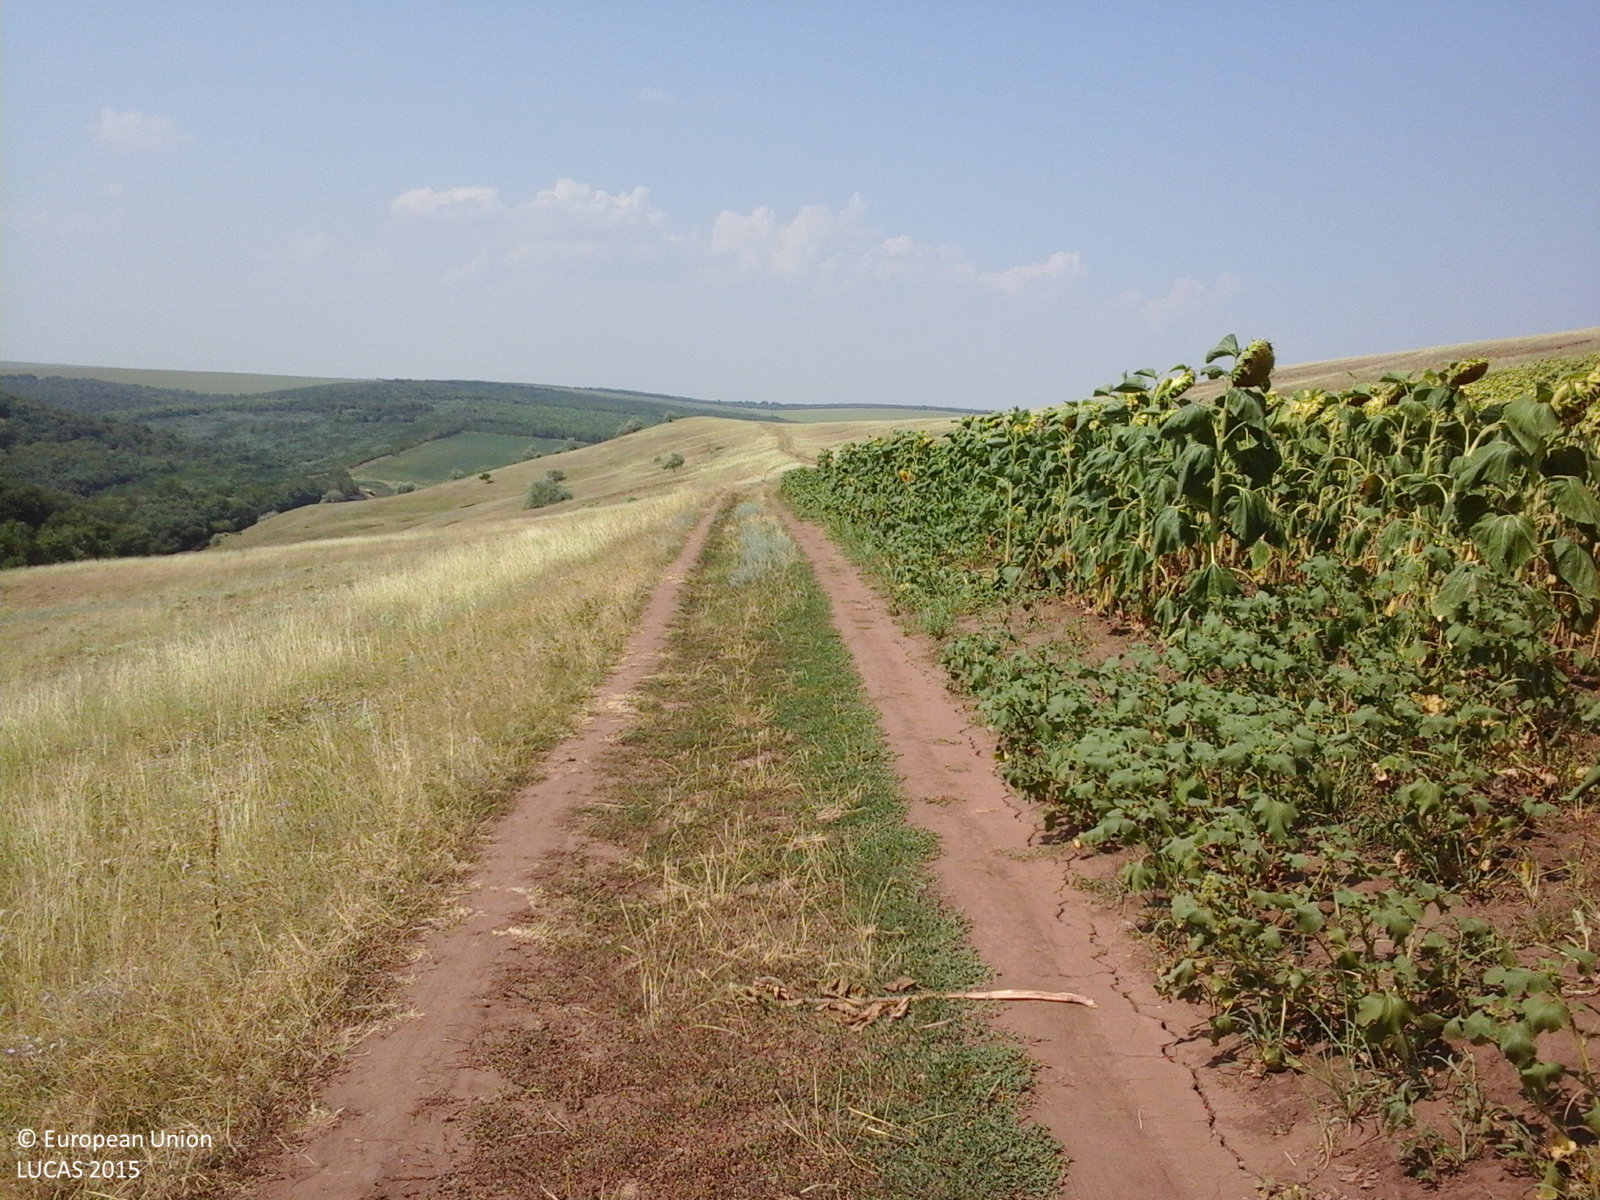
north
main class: Cropland
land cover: Sunflower
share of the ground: > 75 %
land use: Agriculture (excluding fallow land and kitchen gardens)
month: July
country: RO
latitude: 45.7001
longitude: 27.9574
